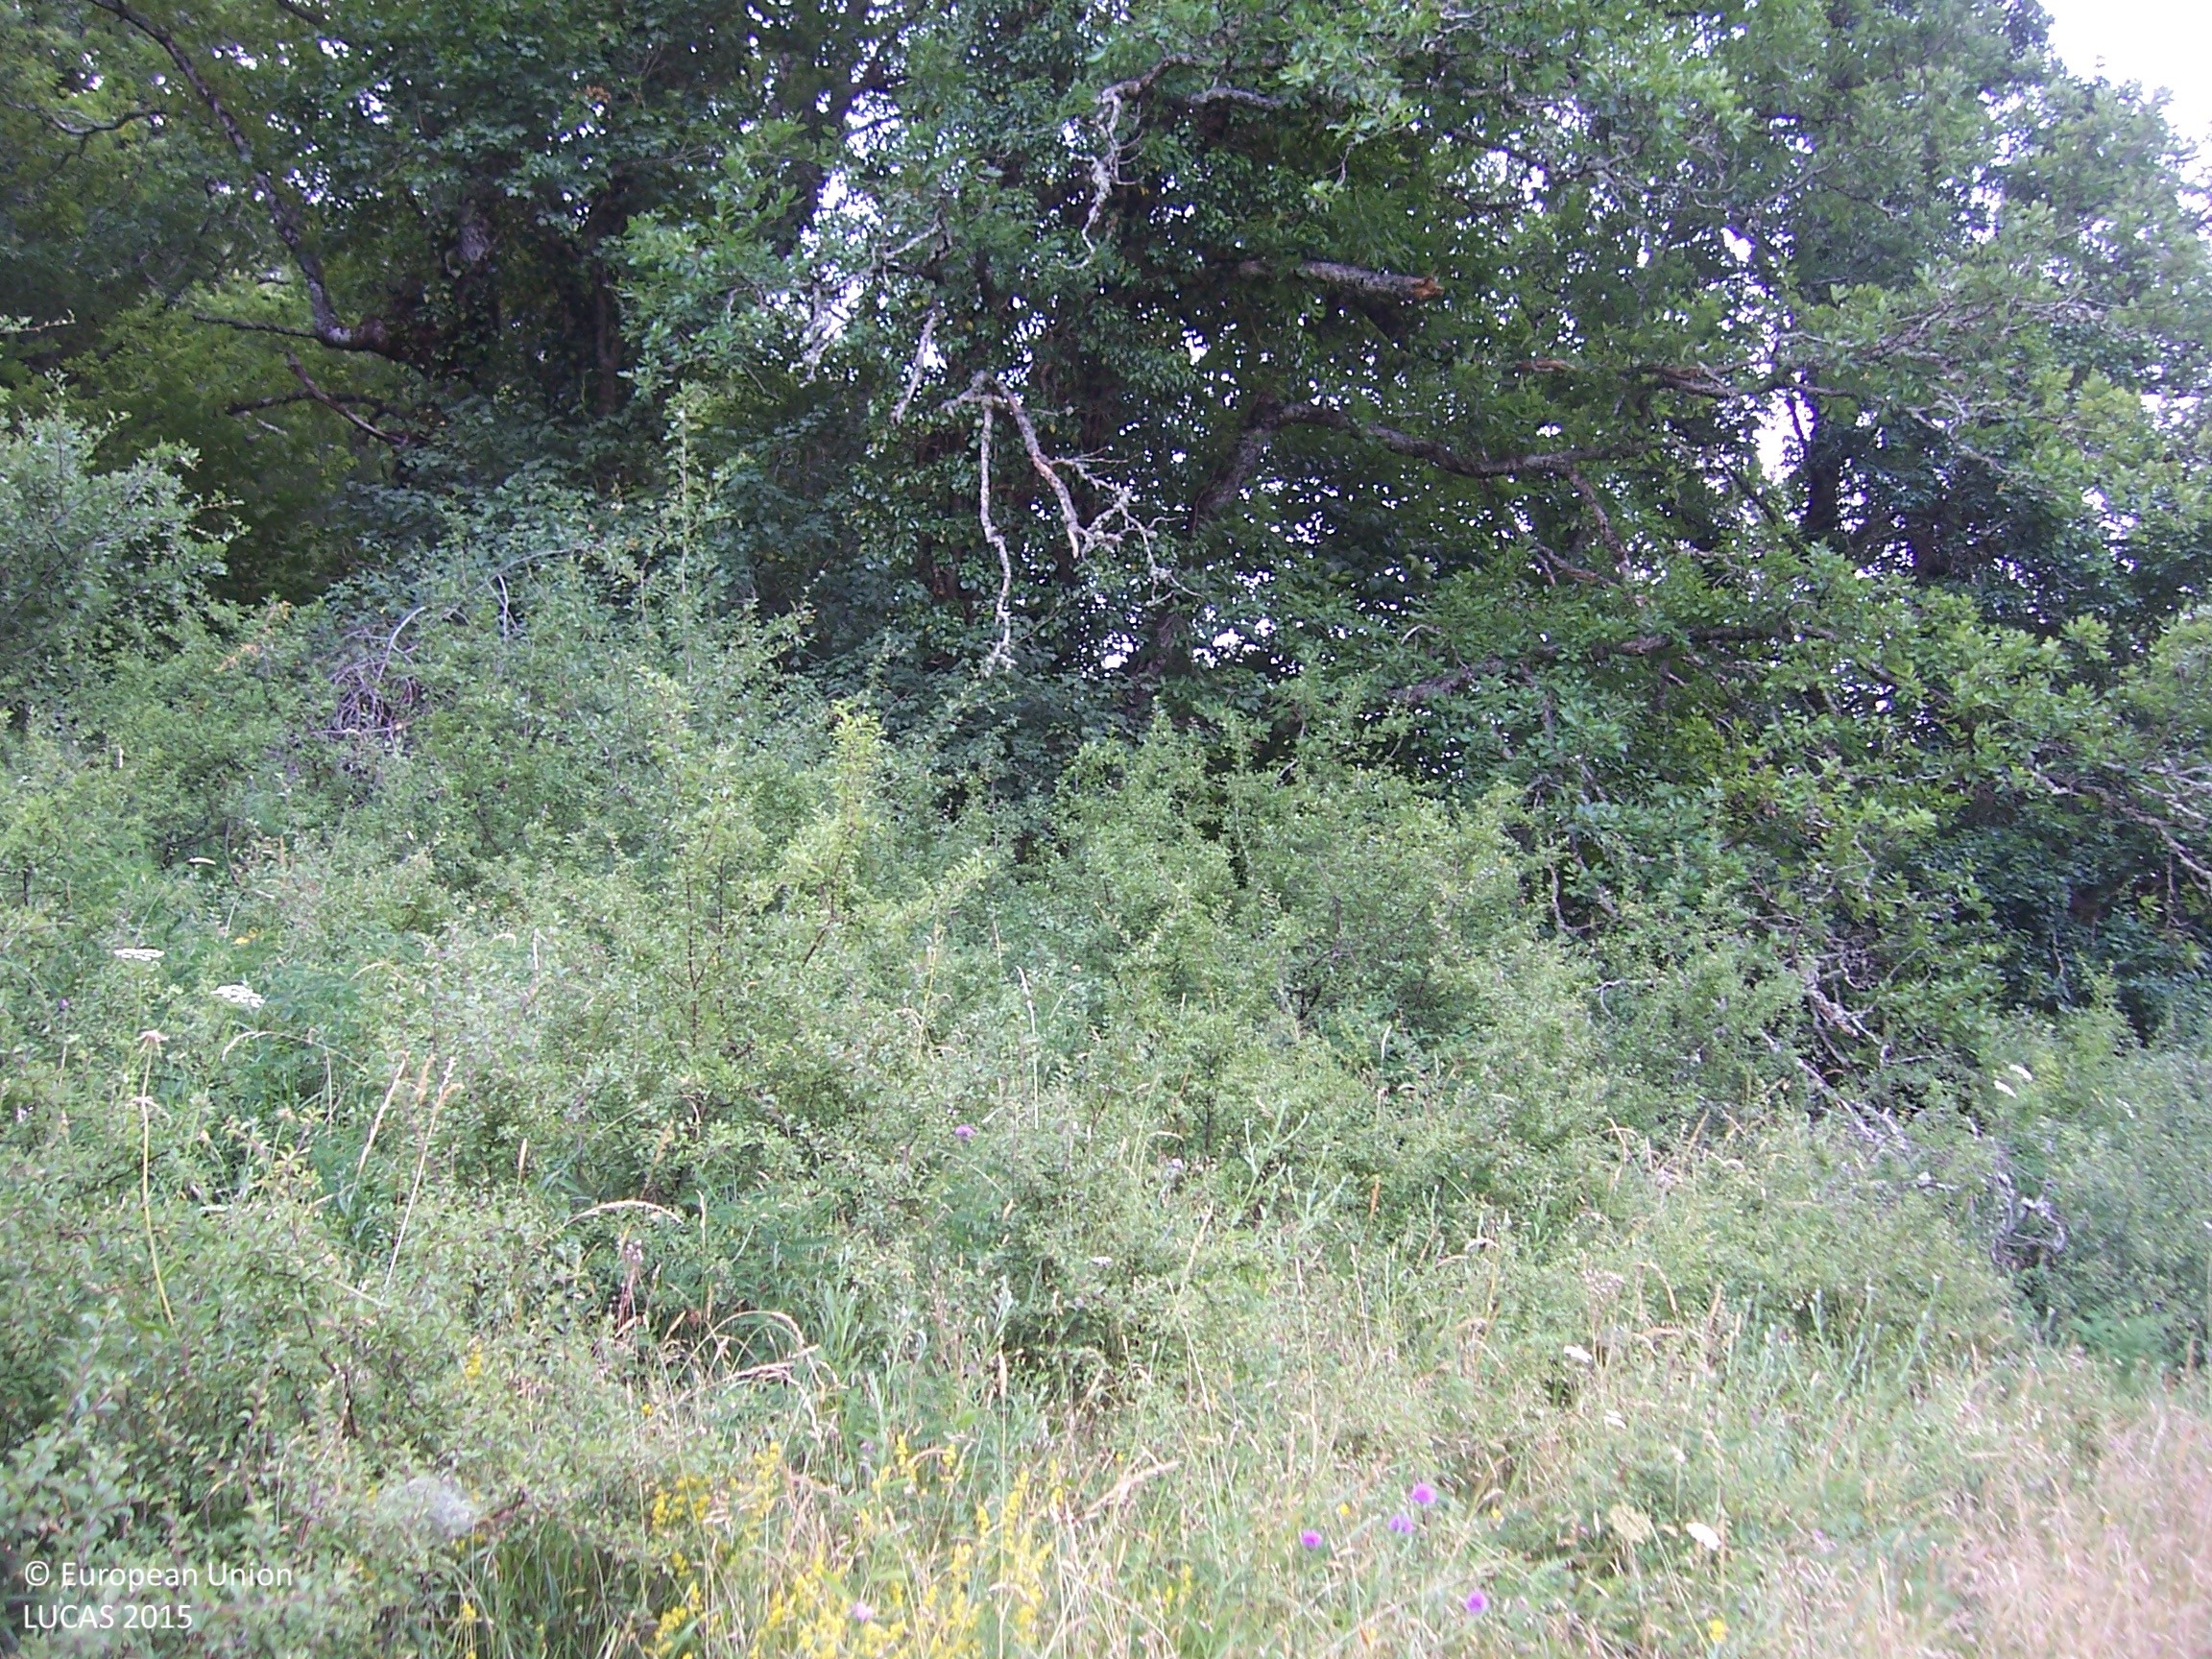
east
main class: Shrubland
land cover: Shrubland without tree cover
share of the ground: > 75 %
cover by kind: shrubs 60 %, herbaceous plants 40 %
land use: Agriculture (excluding fallow land and kitchen gardens)
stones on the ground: < 10 %
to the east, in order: Shrubland without tree cover; Shrubland with sparse tree cover; Broadleaved woodland; Tracks; Broadleaved woodland
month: July
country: ES
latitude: 42.9868
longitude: -1.2831
